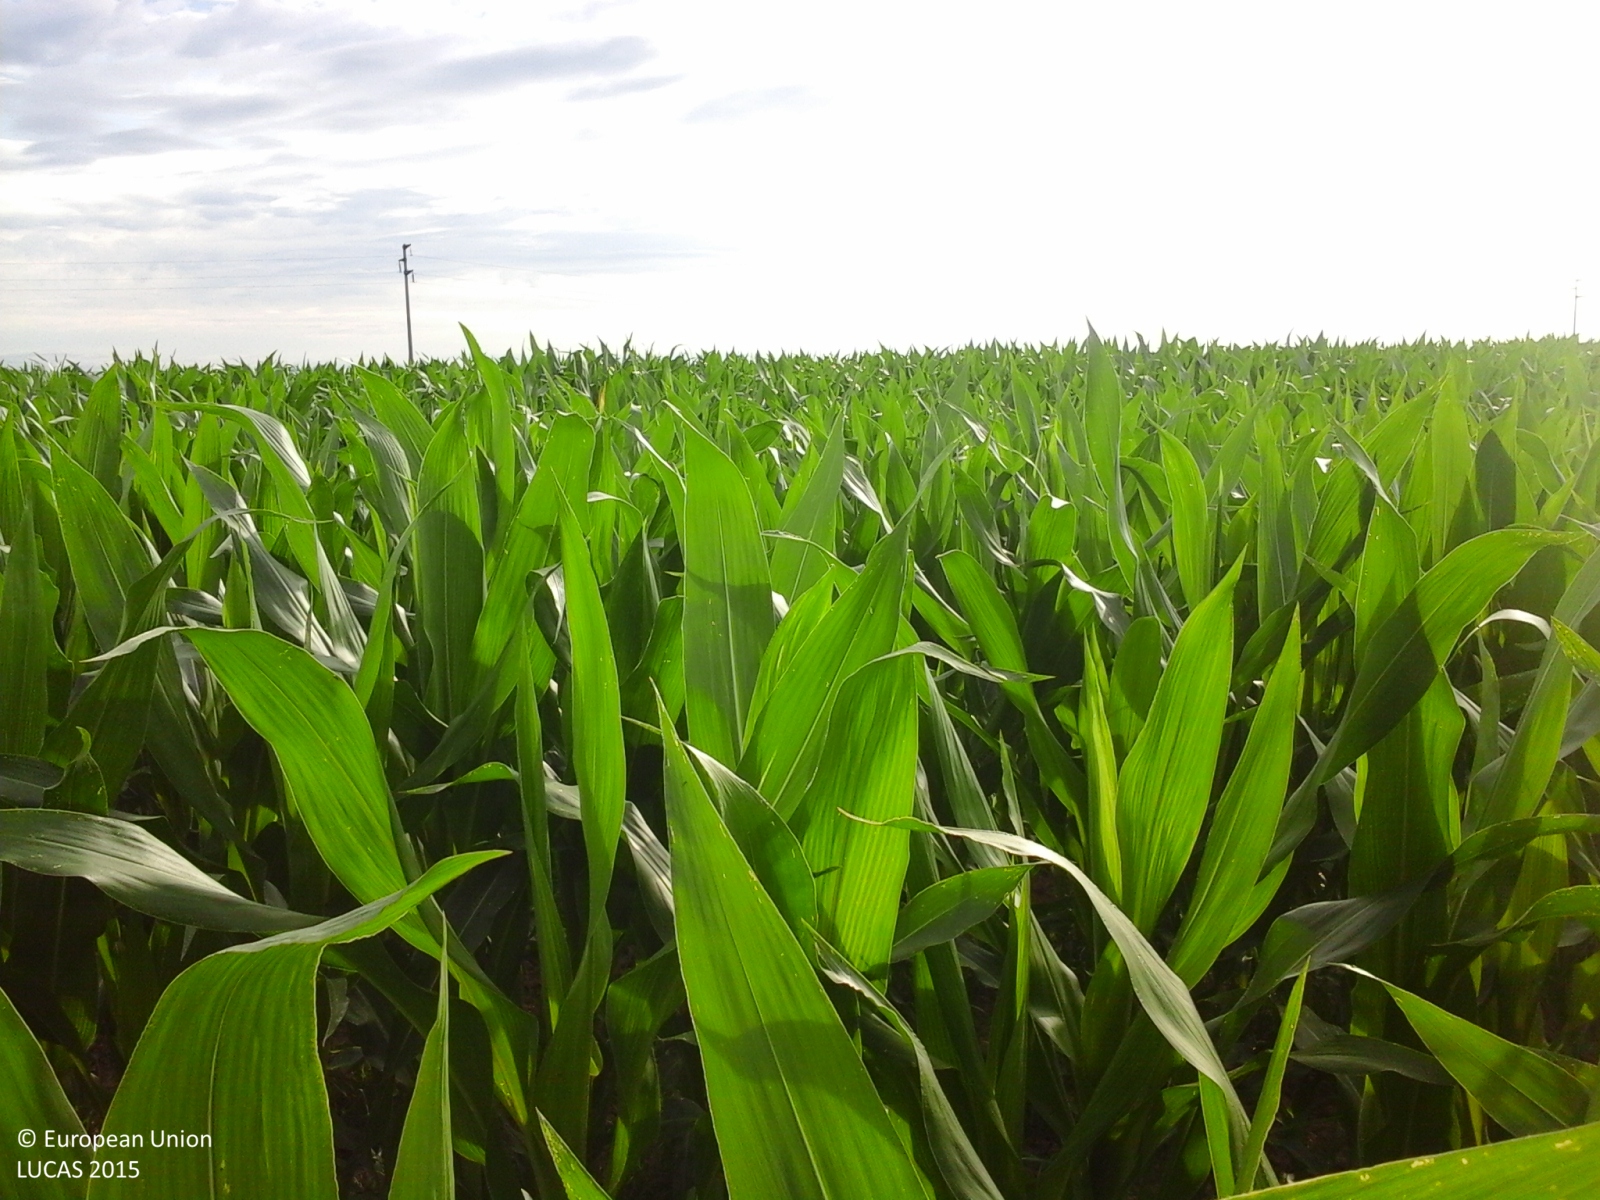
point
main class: Cropland
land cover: Maize
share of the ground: > 75 %
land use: Agriculture (excluding fallow land and kitchen gardens)
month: June
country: IT
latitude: 45.3361
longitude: 11.1337
